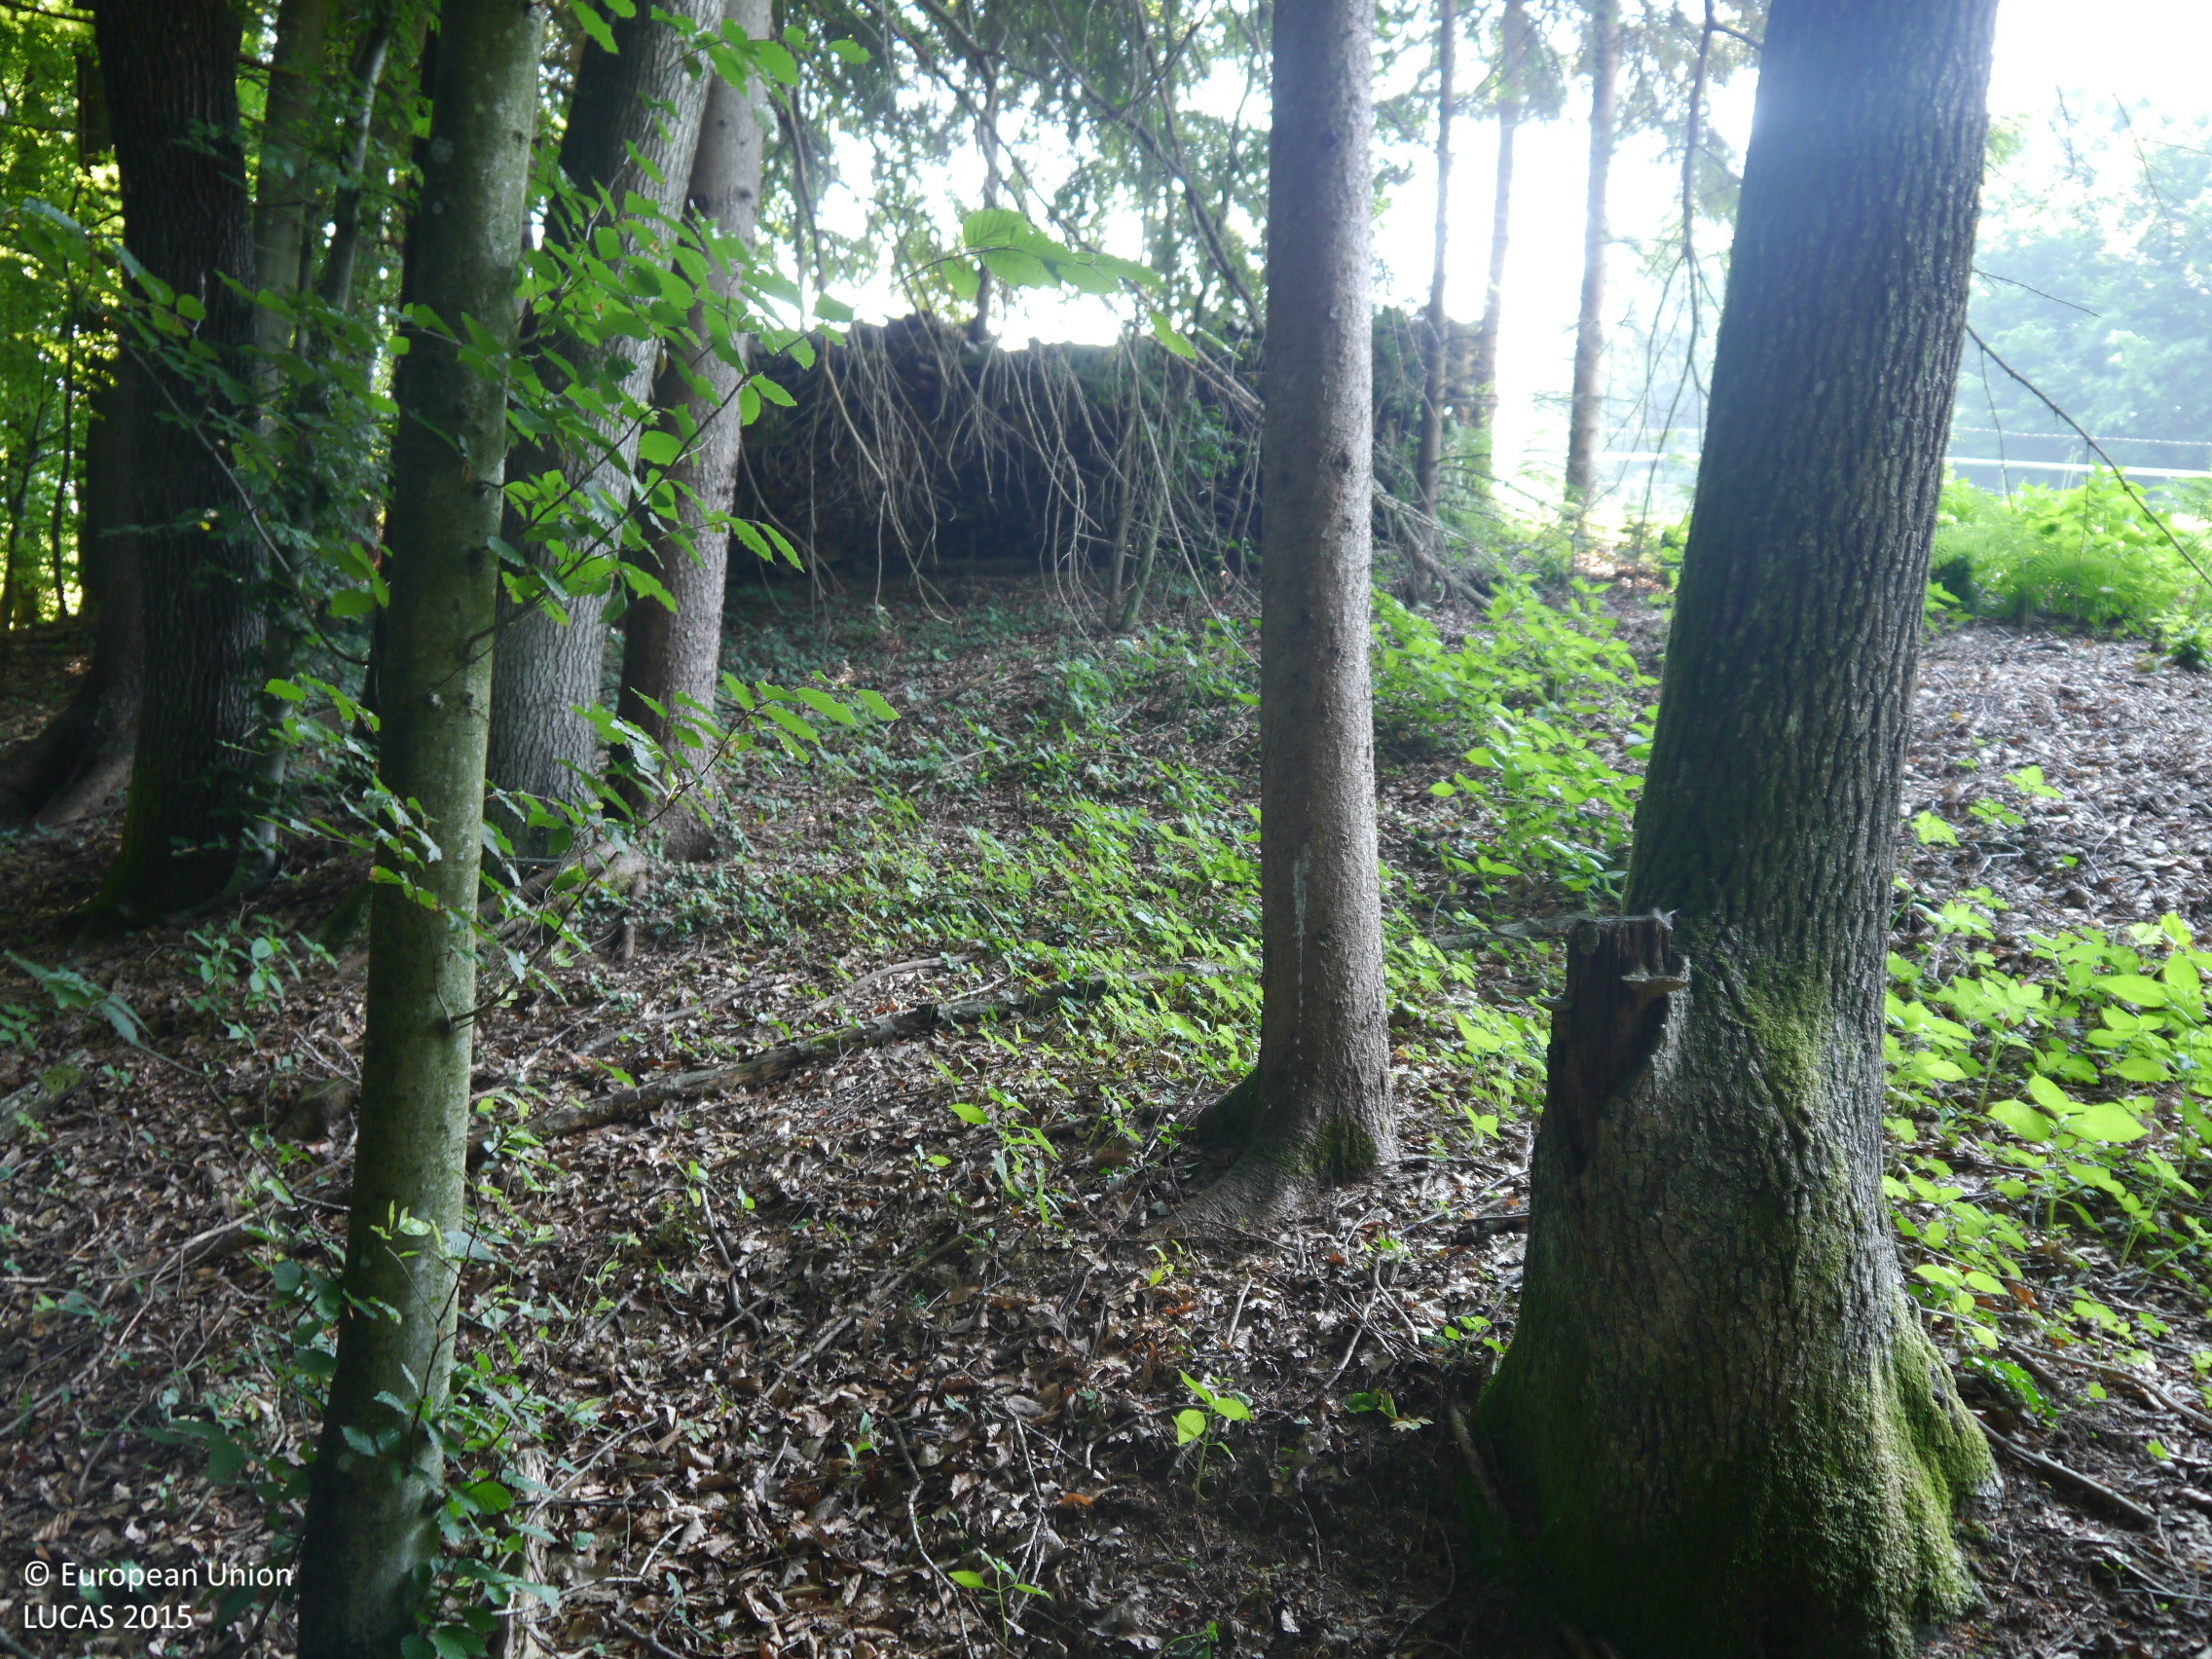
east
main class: Woodland
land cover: Broadleaved woodland
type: mountainous beech forest
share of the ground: > 75 %
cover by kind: broadleaved forest trees 90 %, coniferous forest trees 10 %
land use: Forestry
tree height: > 5 m
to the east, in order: Broadleaved woodland; Tracks; Grass margins; Fences; Grassland without tree/shrub cover; Fences; Grassland without tree/shrub cover; Fences; Grassland without tree/shrub cover; Spontaneously vegetated surfaces; Artificial constructions in urban areas; Pear fruit; Fences; Grassland without tree/shrub cover
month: June
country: AT
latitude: 46.7817
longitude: 15.2512
